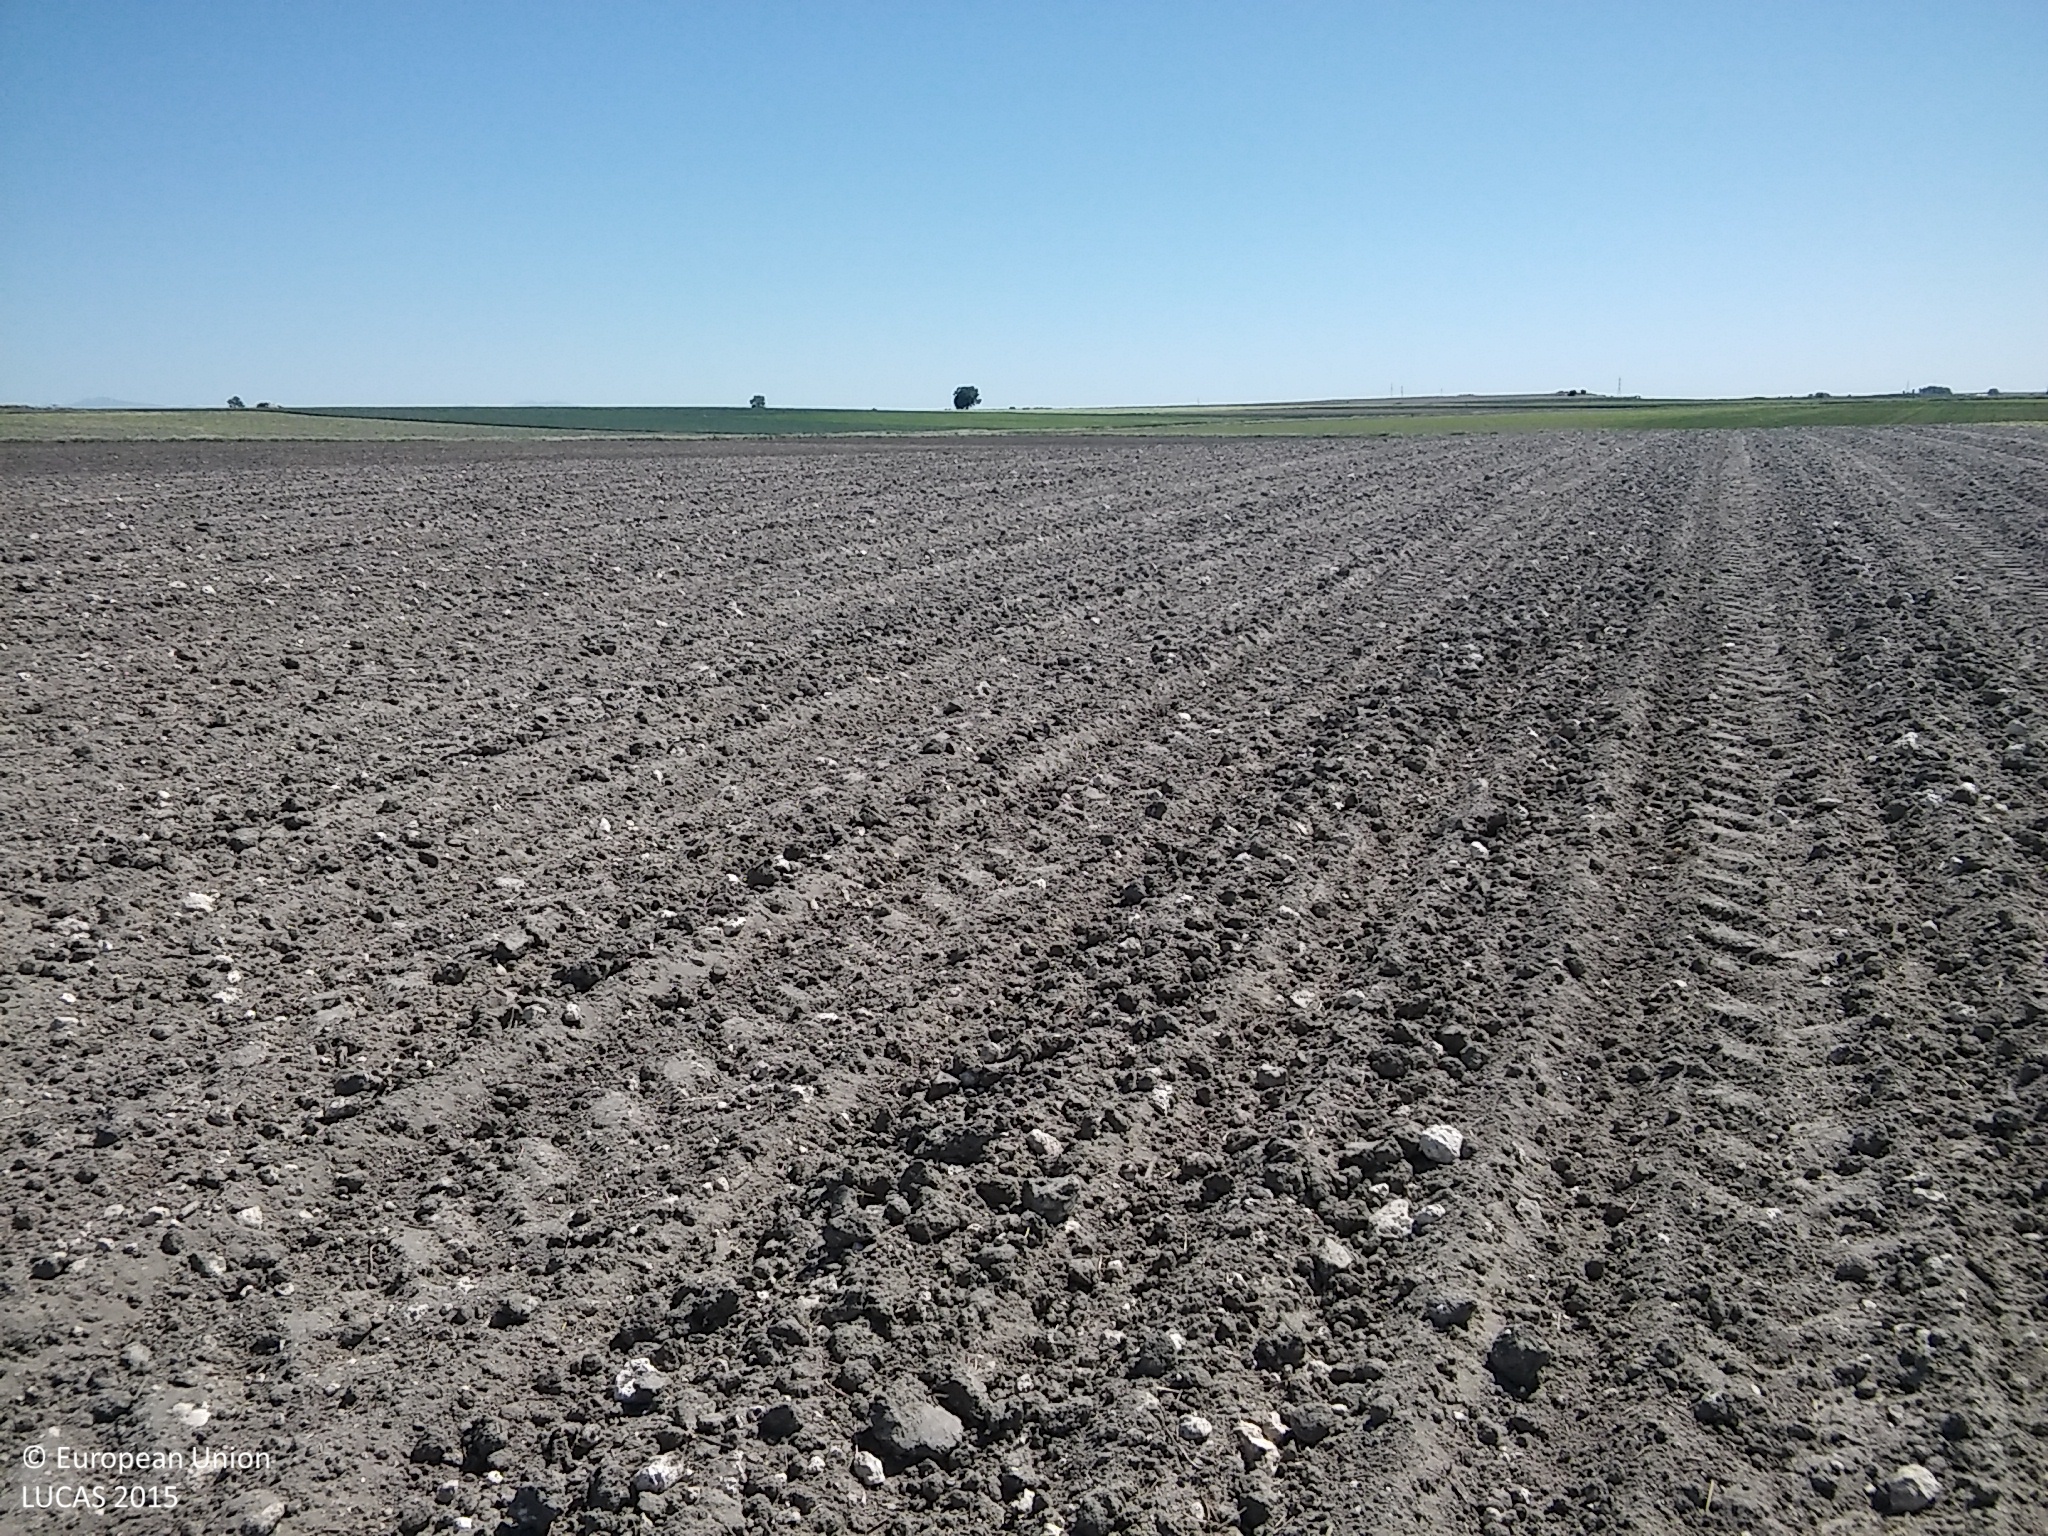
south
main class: Cropland
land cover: Sunflower
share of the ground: < 10 %
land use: Agriculture (excluding fallow land and kitchen gardens)
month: May
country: ES
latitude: 41.3721
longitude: -4.0794
